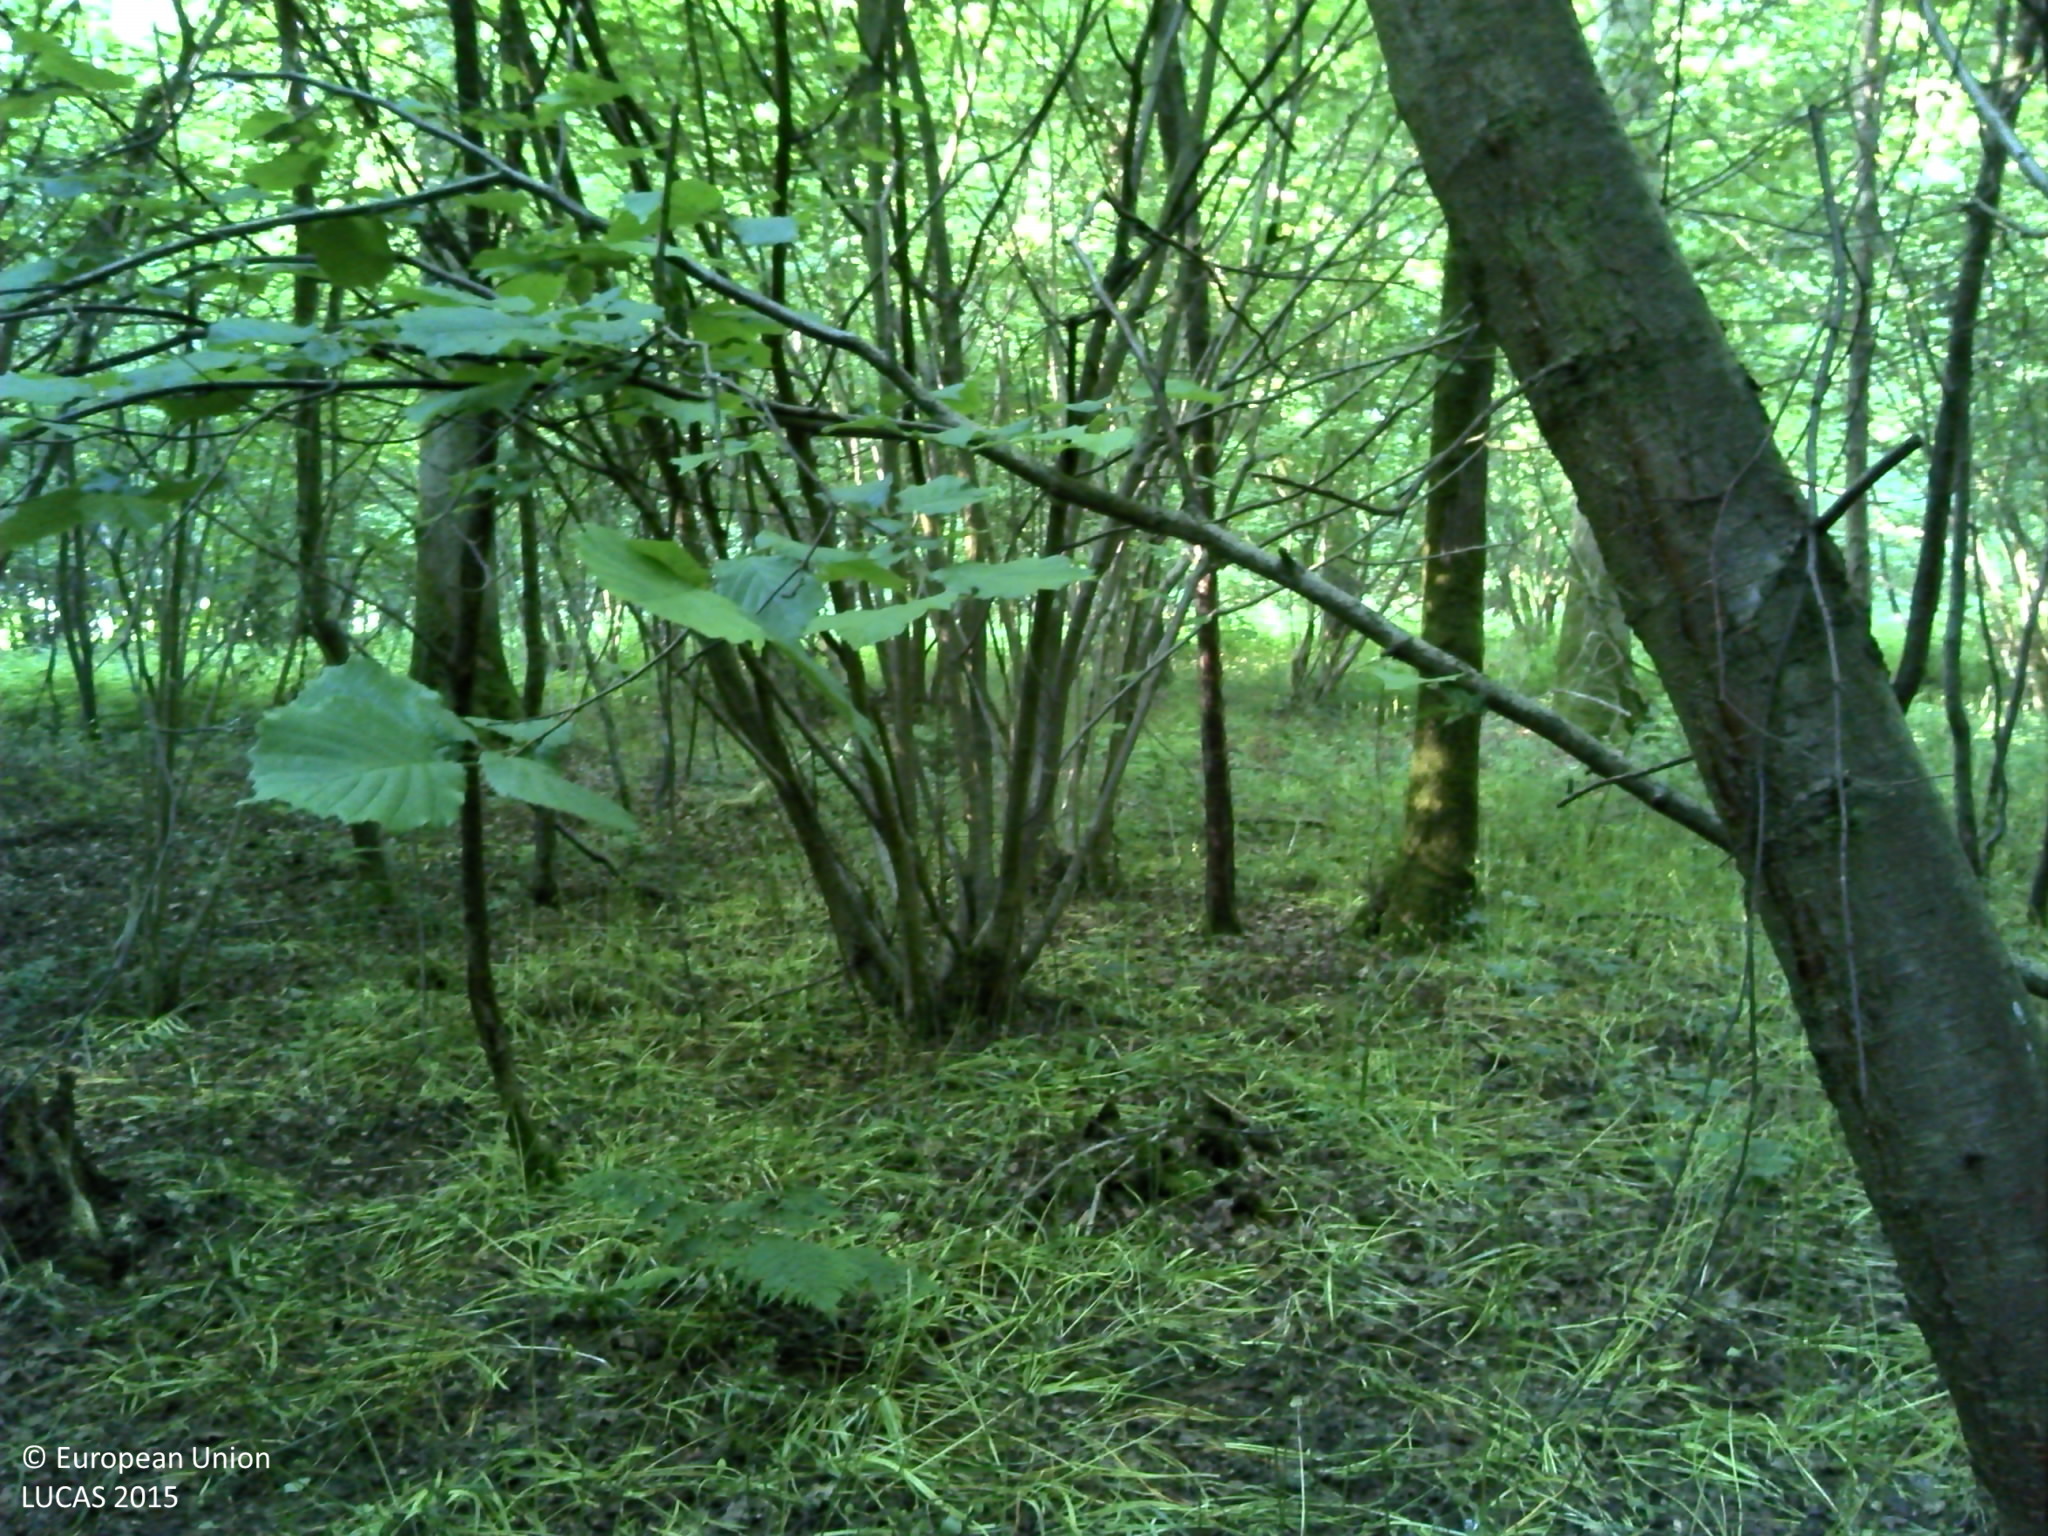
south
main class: Woodland
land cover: Broadleaved woodland
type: mesophytic deciduous forest
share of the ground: > 75 %
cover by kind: broadleaved forest trees 80 %, herbaceous plants 20 %
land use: Forestry
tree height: > 5 m
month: June
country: FR
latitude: 49.6946
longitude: 1.1478
